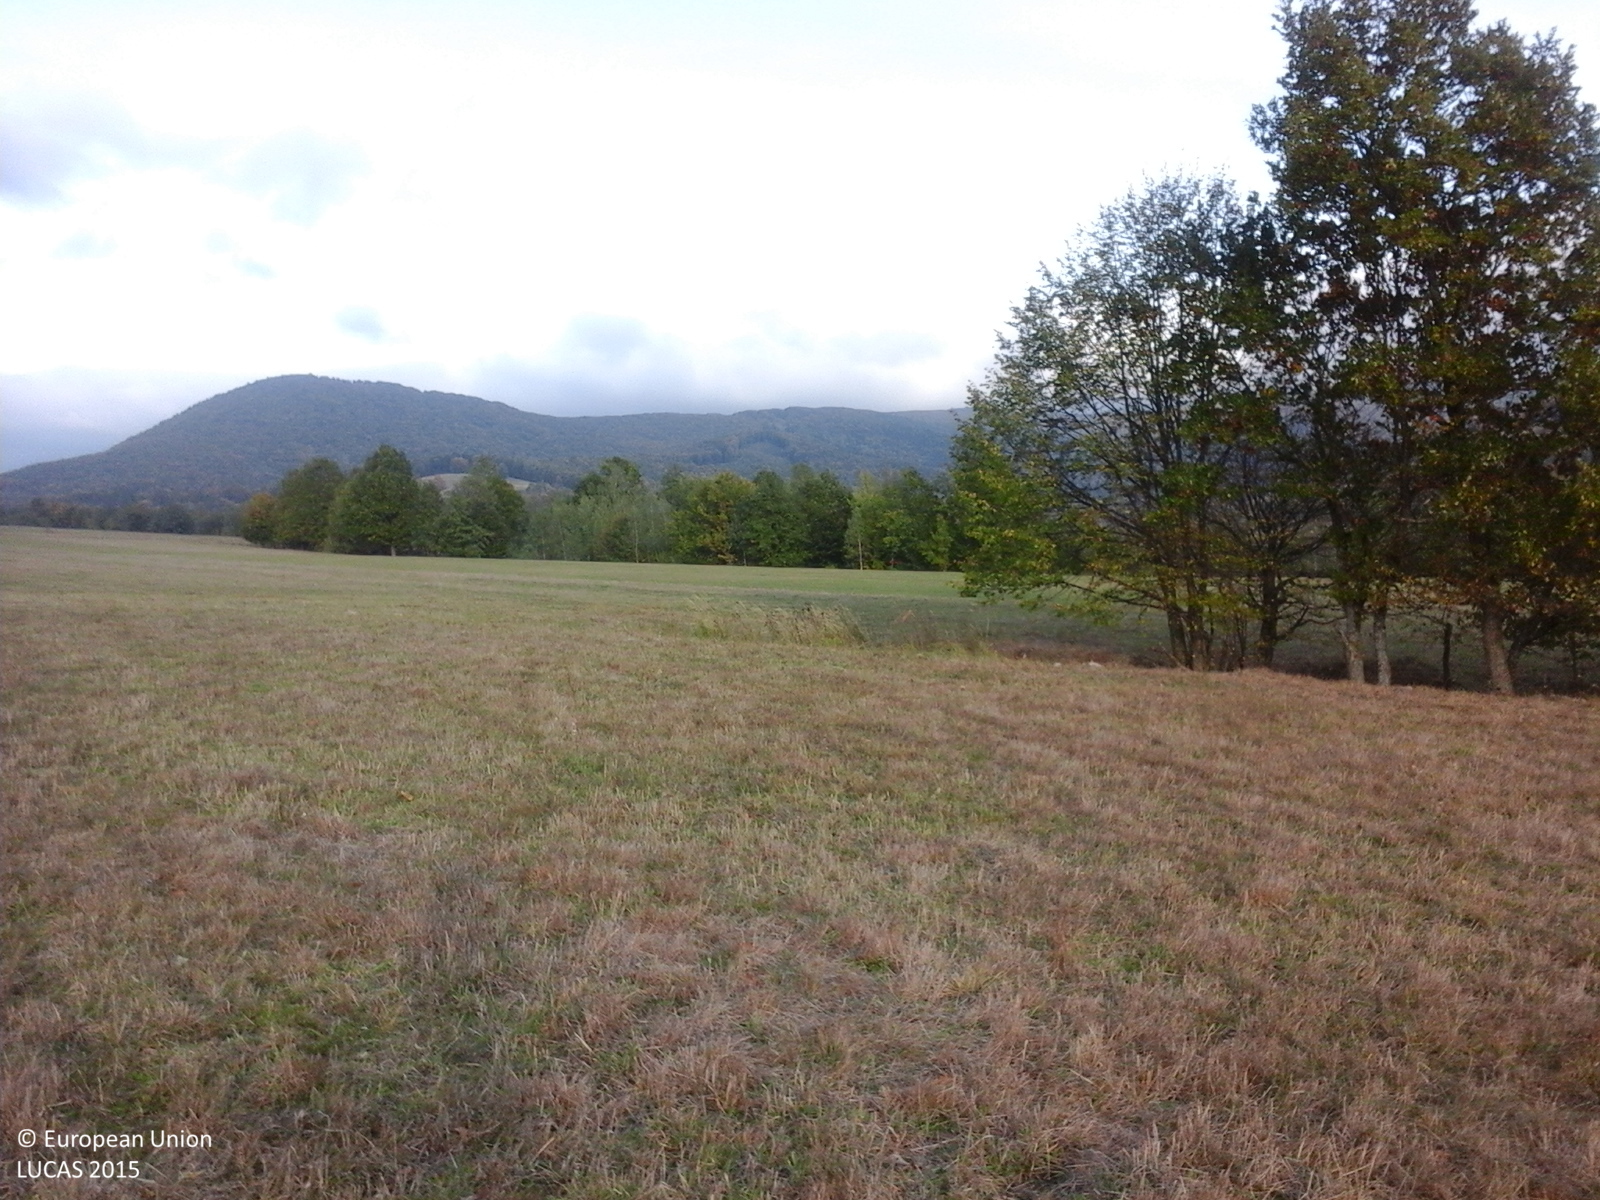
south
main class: Grassland
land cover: Grassland without tree/shrub cover
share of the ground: > 75 %
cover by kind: herbaceous plants 100 %
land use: Agriculture (excluding fallow land and kitchen gardens)
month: October
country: RO
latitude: 46.0906
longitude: 25.8808
